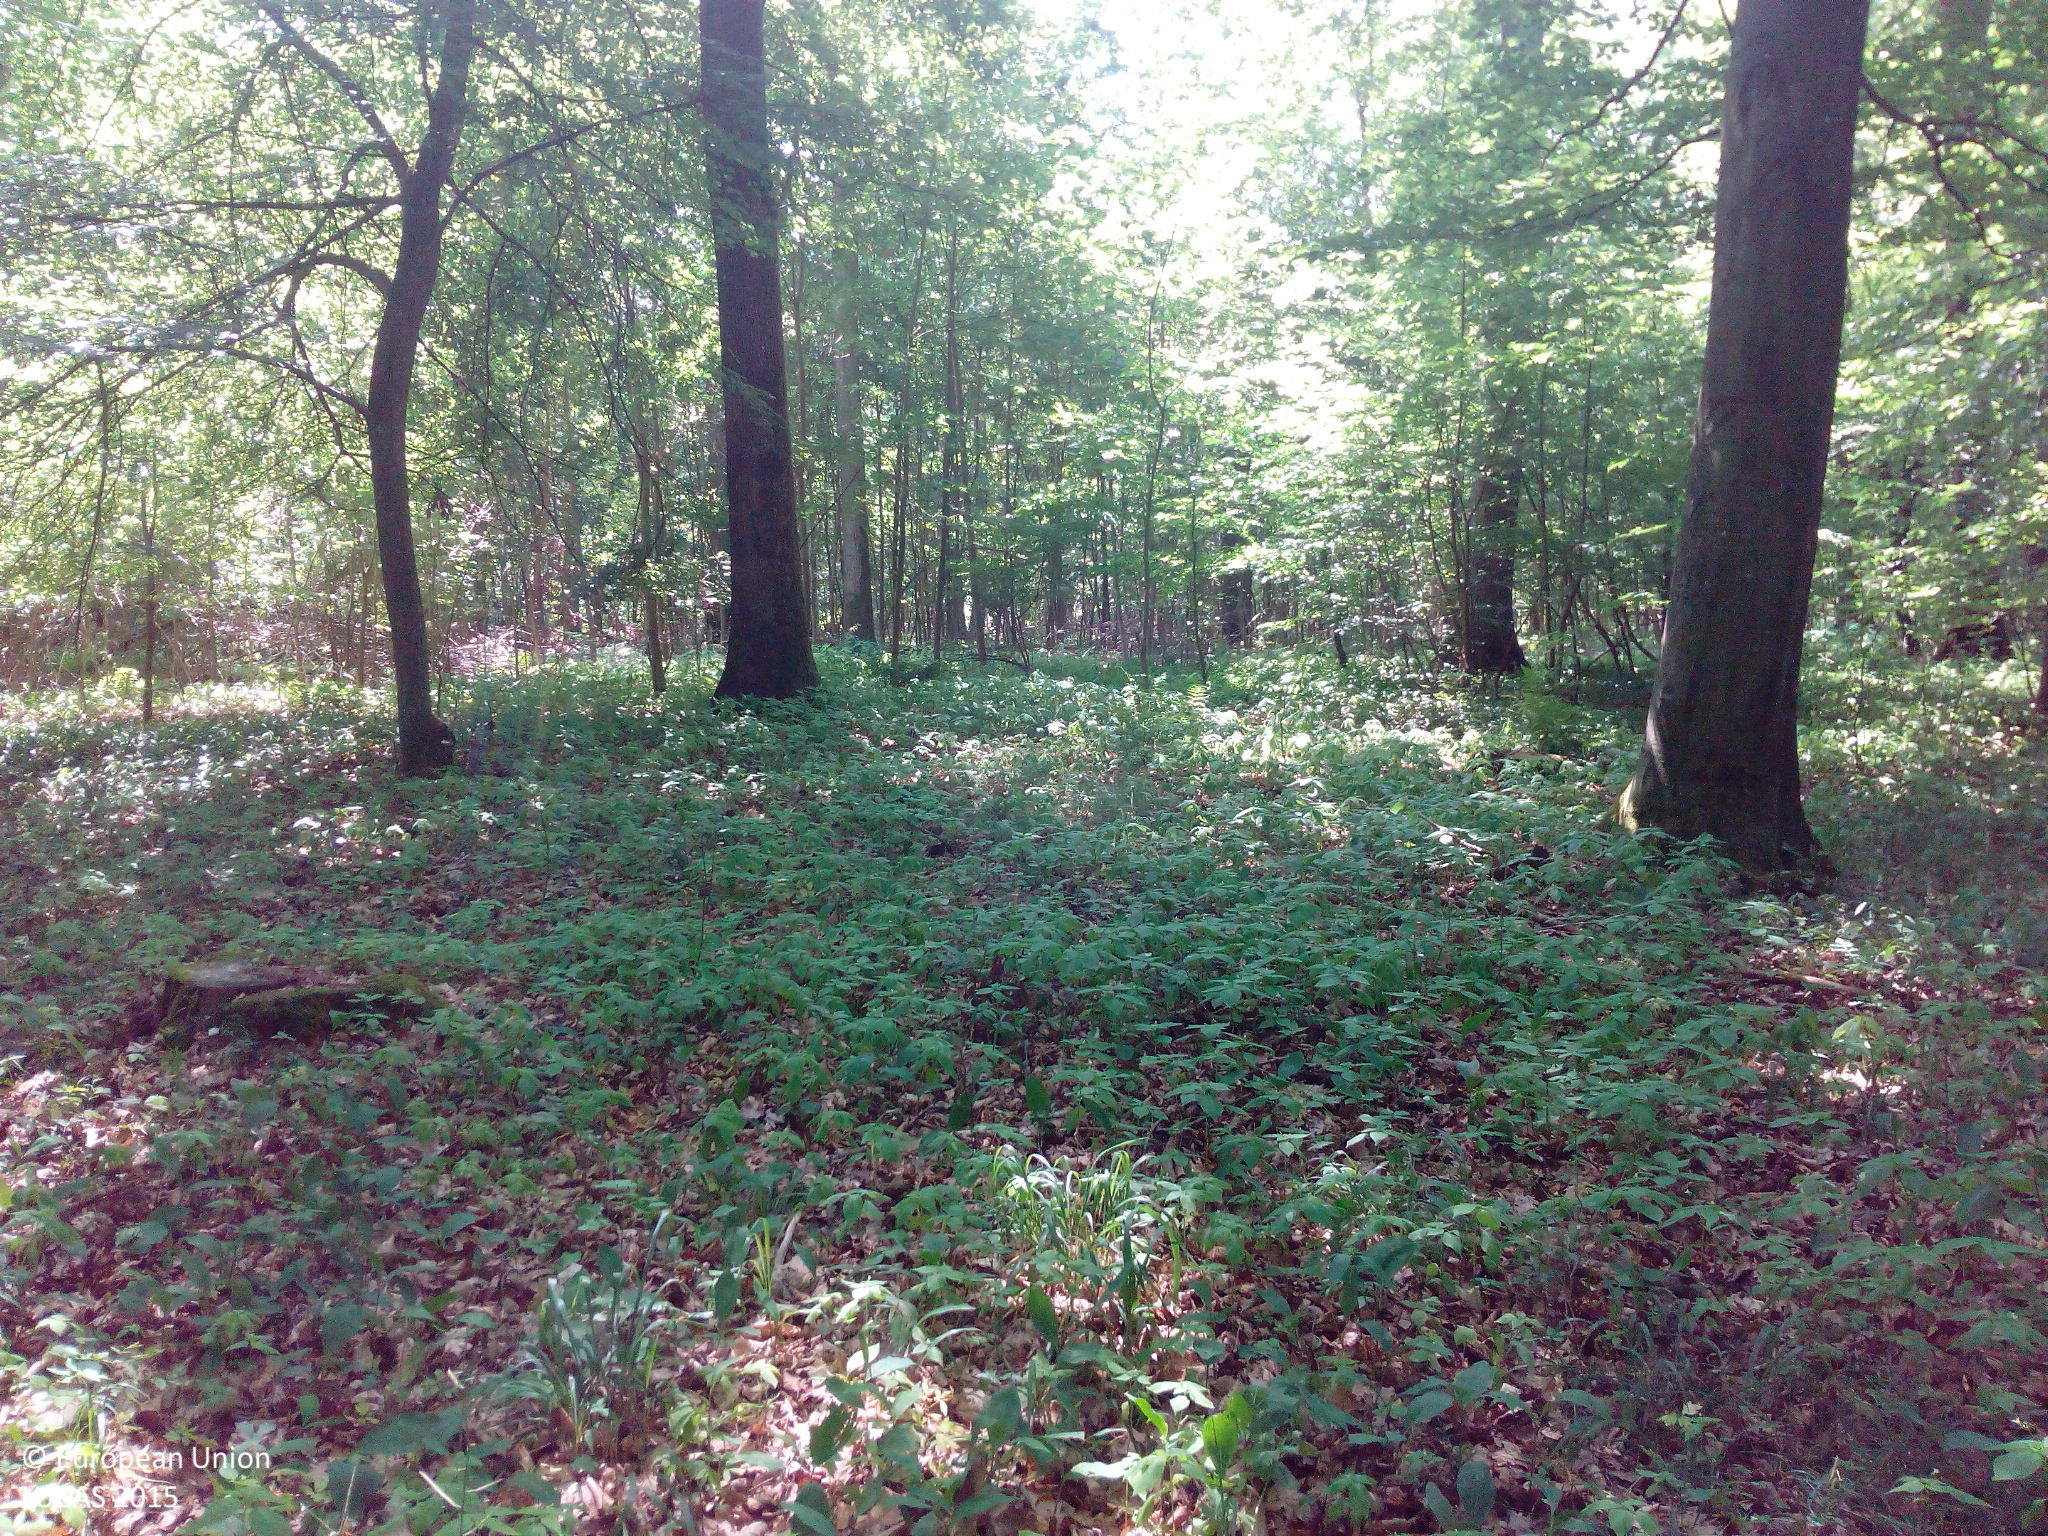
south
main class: Woodland
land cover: Broadleaved woodland
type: mesophytic deciduous forest
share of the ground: > 75 %
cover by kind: broadleaved forest trees 90 %, herbaceous plants 10 %
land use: Forestry
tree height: > 5 m
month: July
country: DE
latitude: 49.5368
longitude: 9.9309
